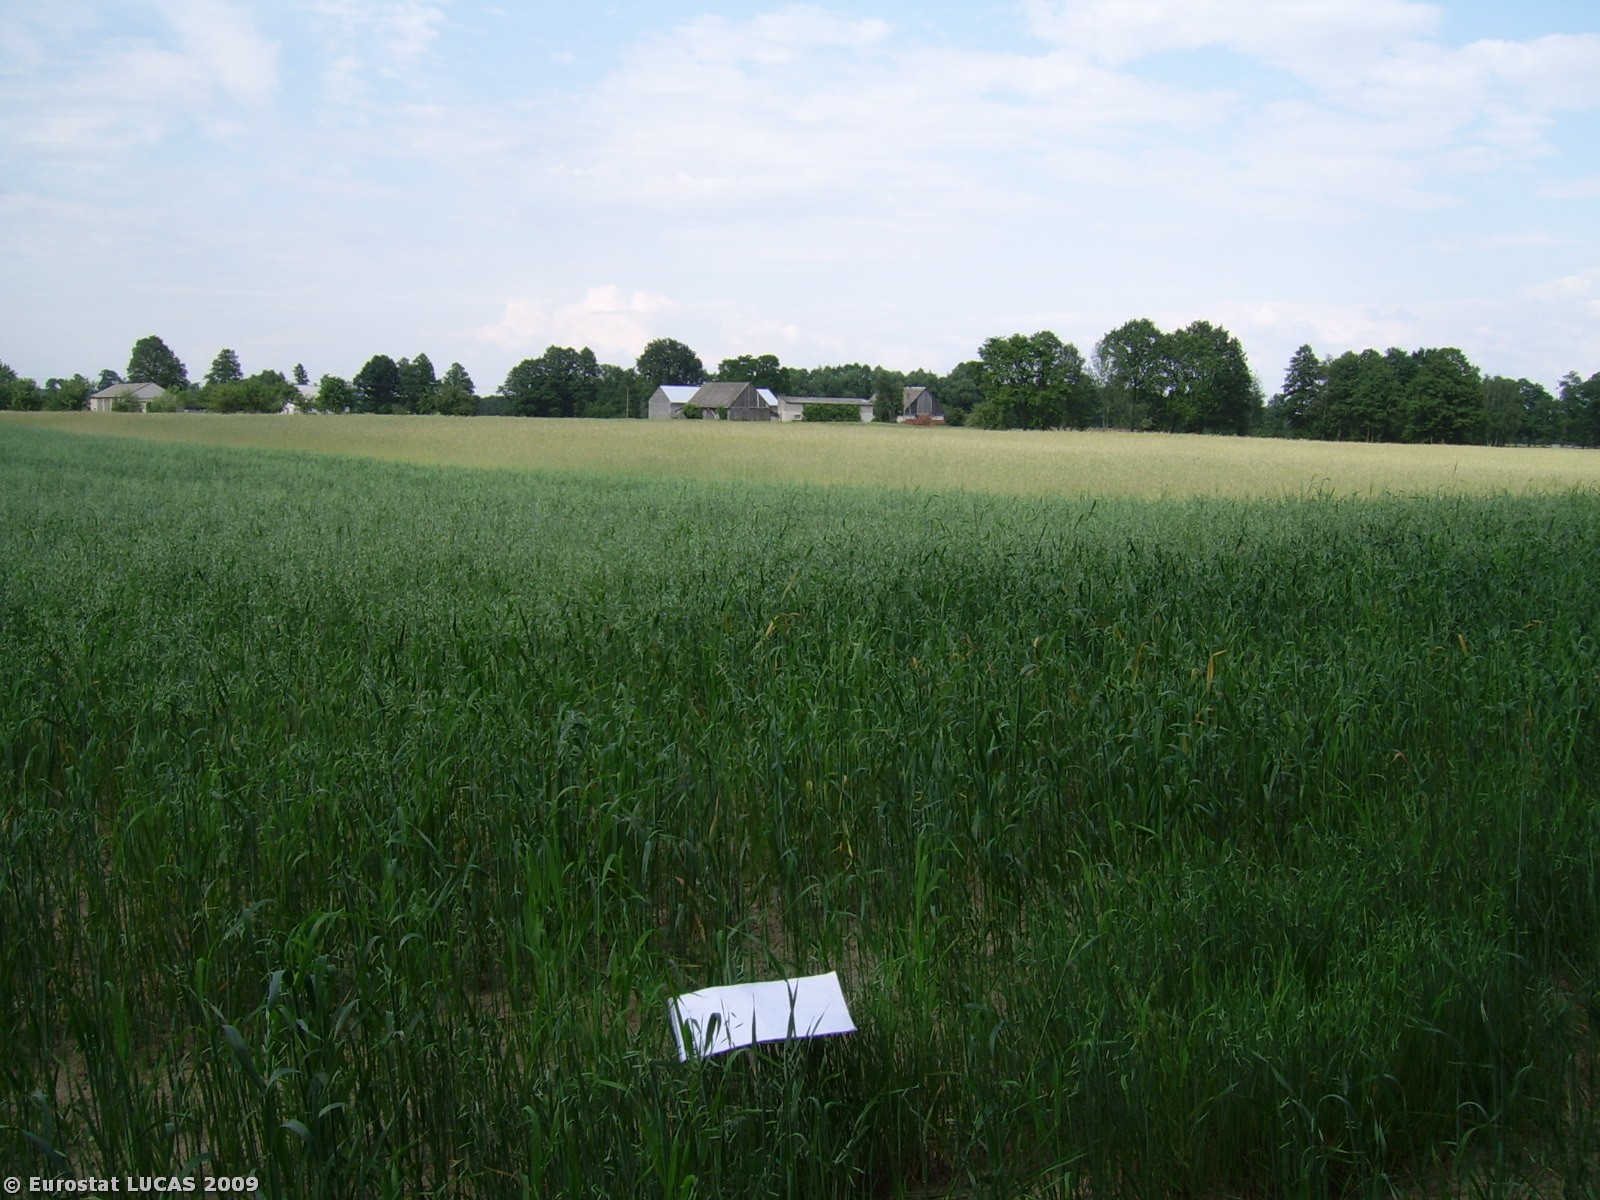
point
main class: Cropland
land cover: Oats
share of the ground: > 75 %
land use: Agriculture (excluding fallow land and kitchen gardens)
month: June
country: PL
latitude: 52.1029
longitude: 17.7959
